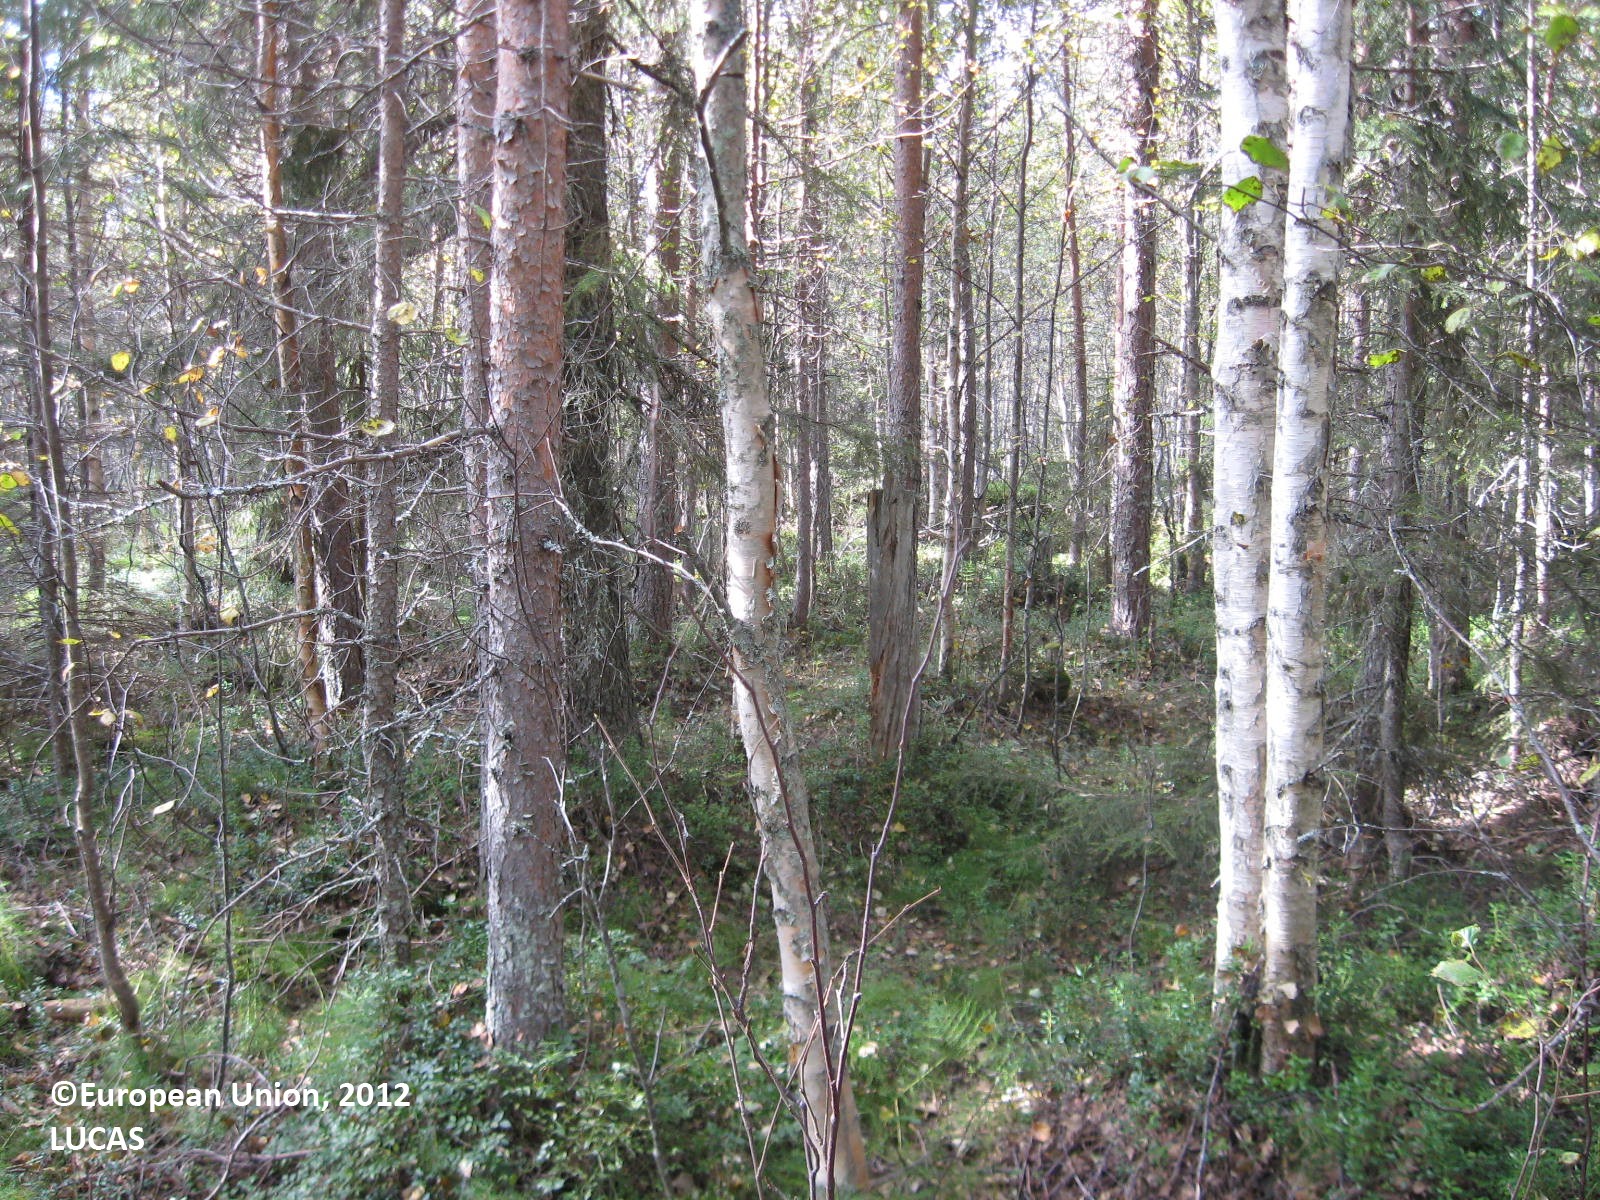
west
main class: Woodland
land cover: Other mixed woodland
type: boreal forest
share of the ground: > 75 %
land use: Forestry
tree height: > 5 m
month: August
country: FI
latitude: 63.9292
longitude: 30.1321
